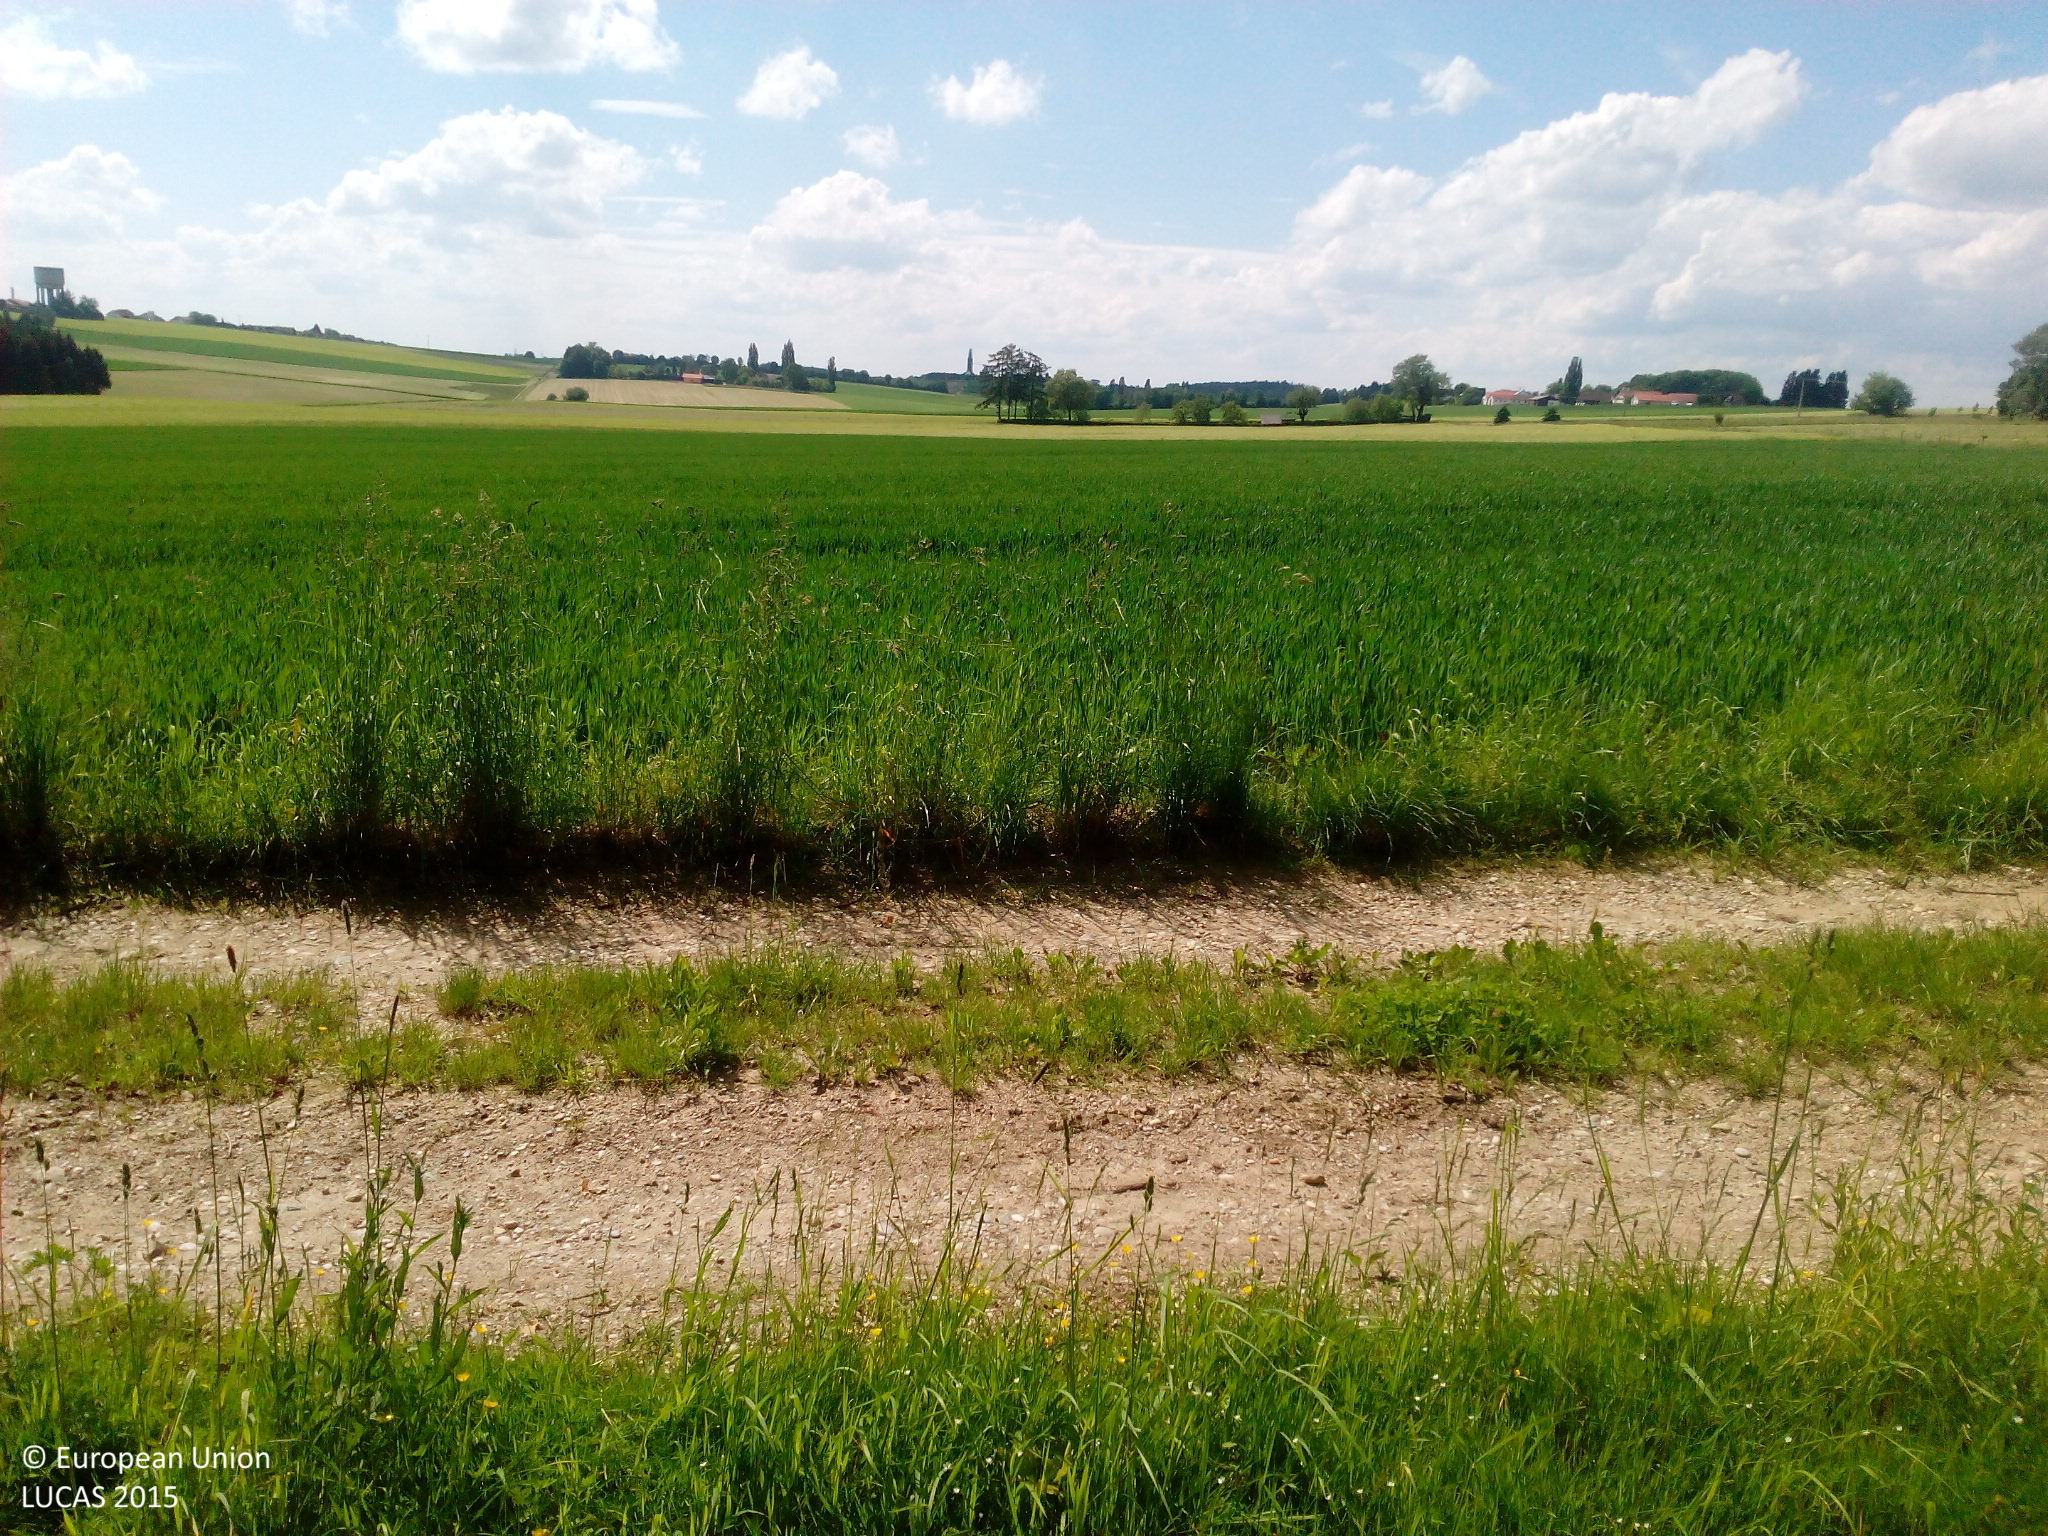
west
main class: Woodland
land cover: Broadleaved woodland
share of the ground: 25 - 50 %
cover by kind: herbaceous plants 55 %, broadleaved forest trees 40 %, coniferous forest trees 5 %
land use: Forestry
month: June
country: DE
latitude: 48.5227
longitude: 12.3415
